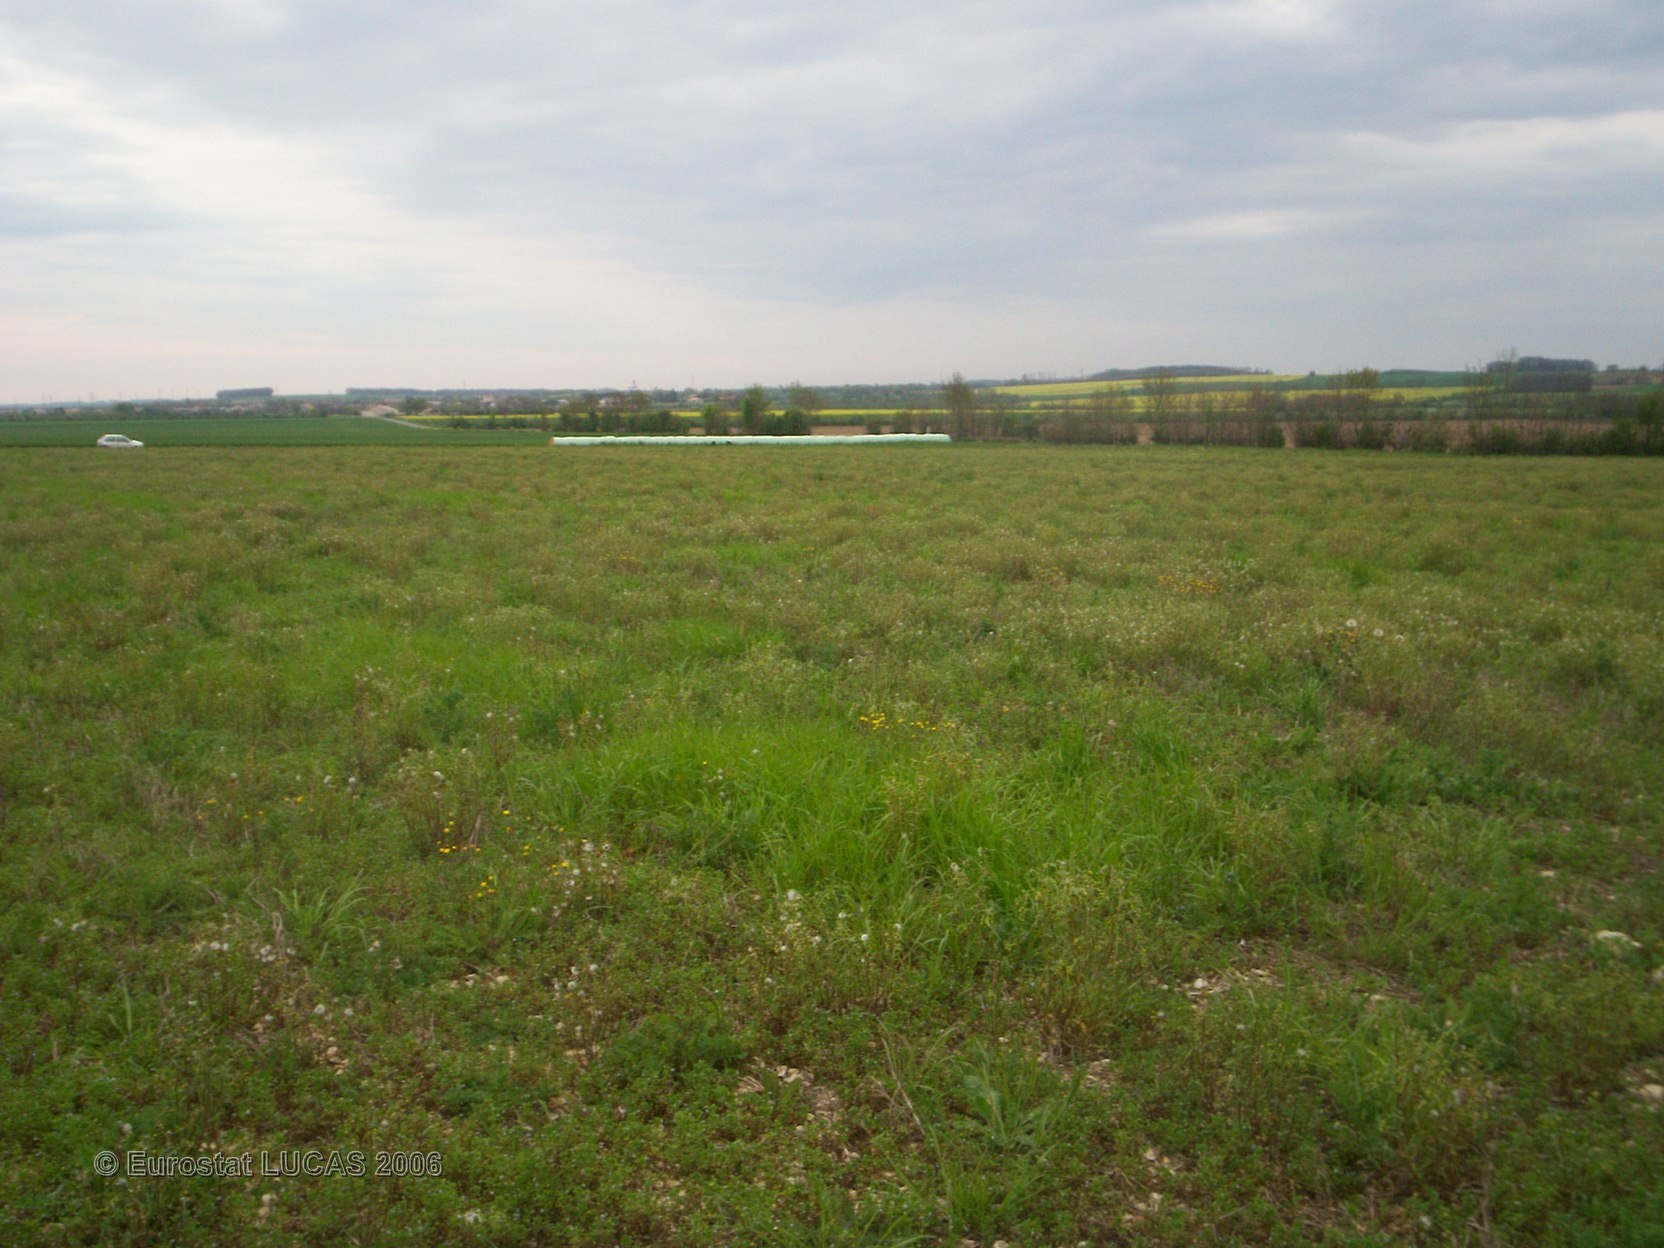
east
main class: Grassland
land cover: Grassland without tree/shrub cover
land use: Agriculture (excluding fallow land and kitchen gardens)
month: April
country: FR
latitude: 46.1036
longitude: -0.6993
